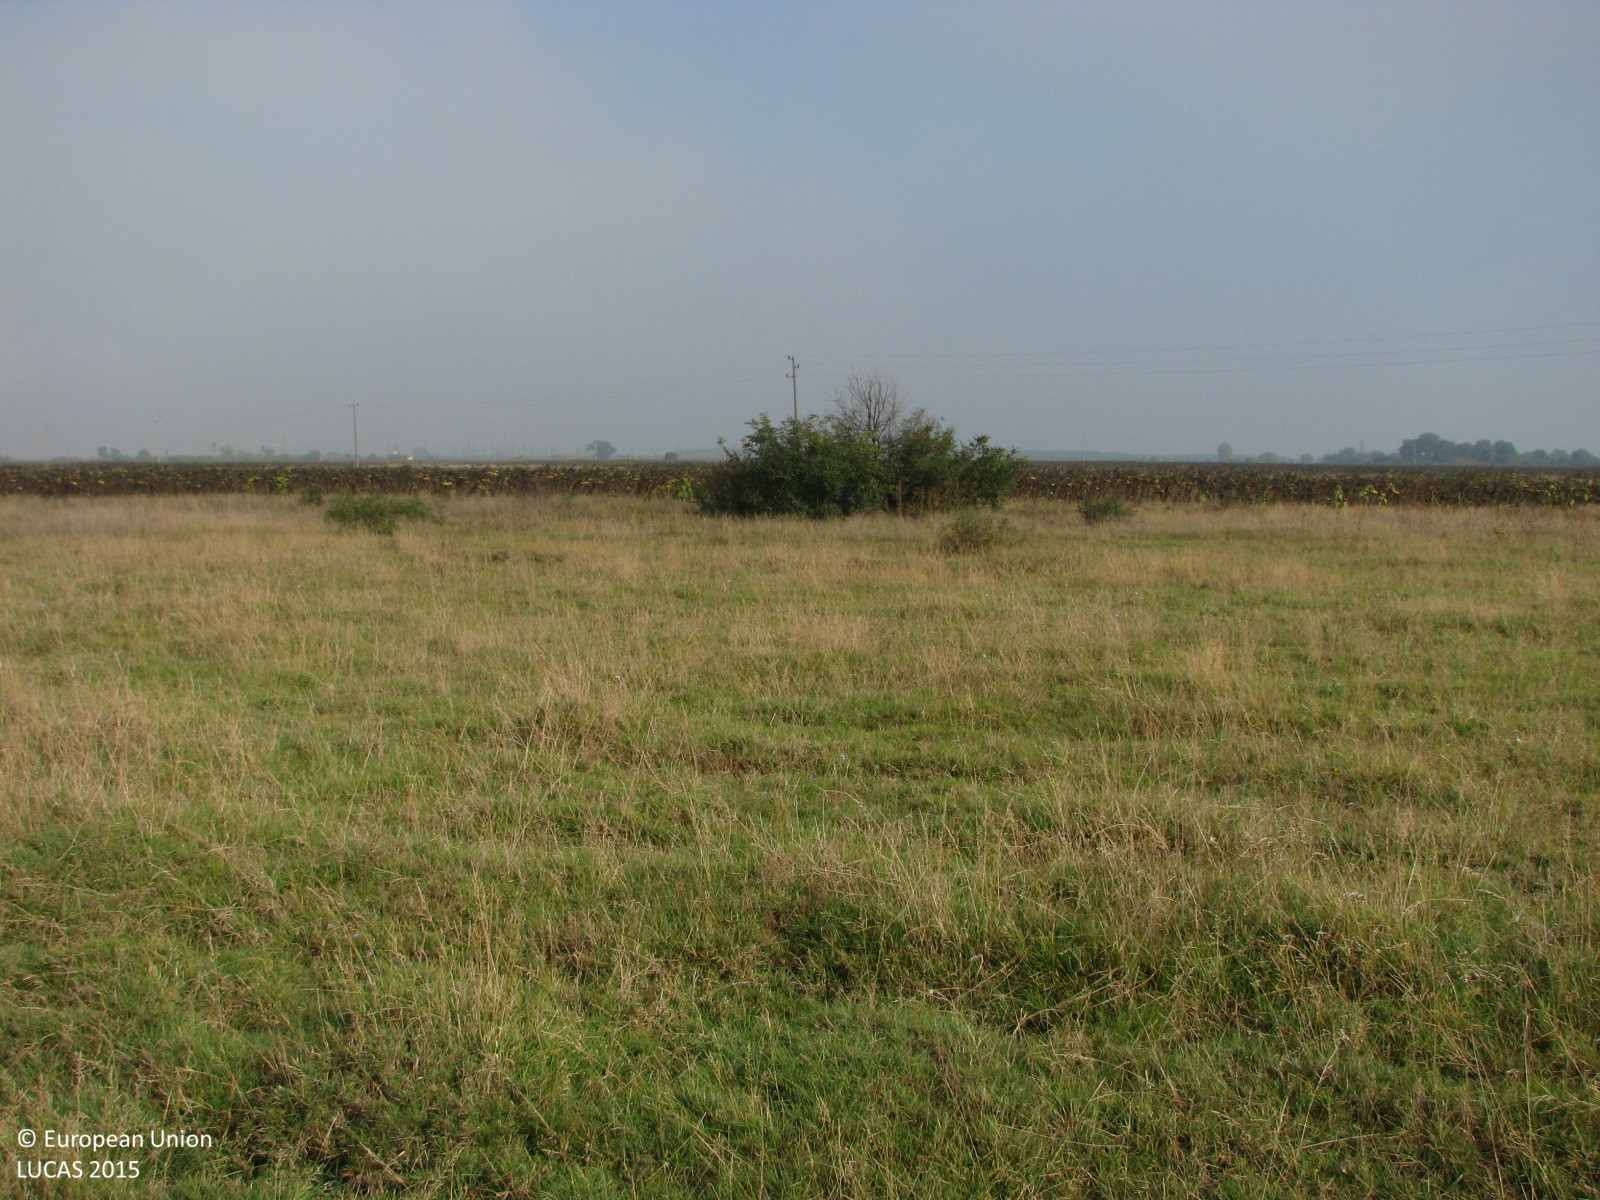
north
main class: Grassland
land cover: Grassland without tree/shrub cover
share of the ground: > 75 %
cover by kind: herbaceous plants 100 %
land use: Agriculture (excluding fallow land and kitchen gardens)
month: October
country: BG
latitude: 42.4192
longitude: 25.8883
